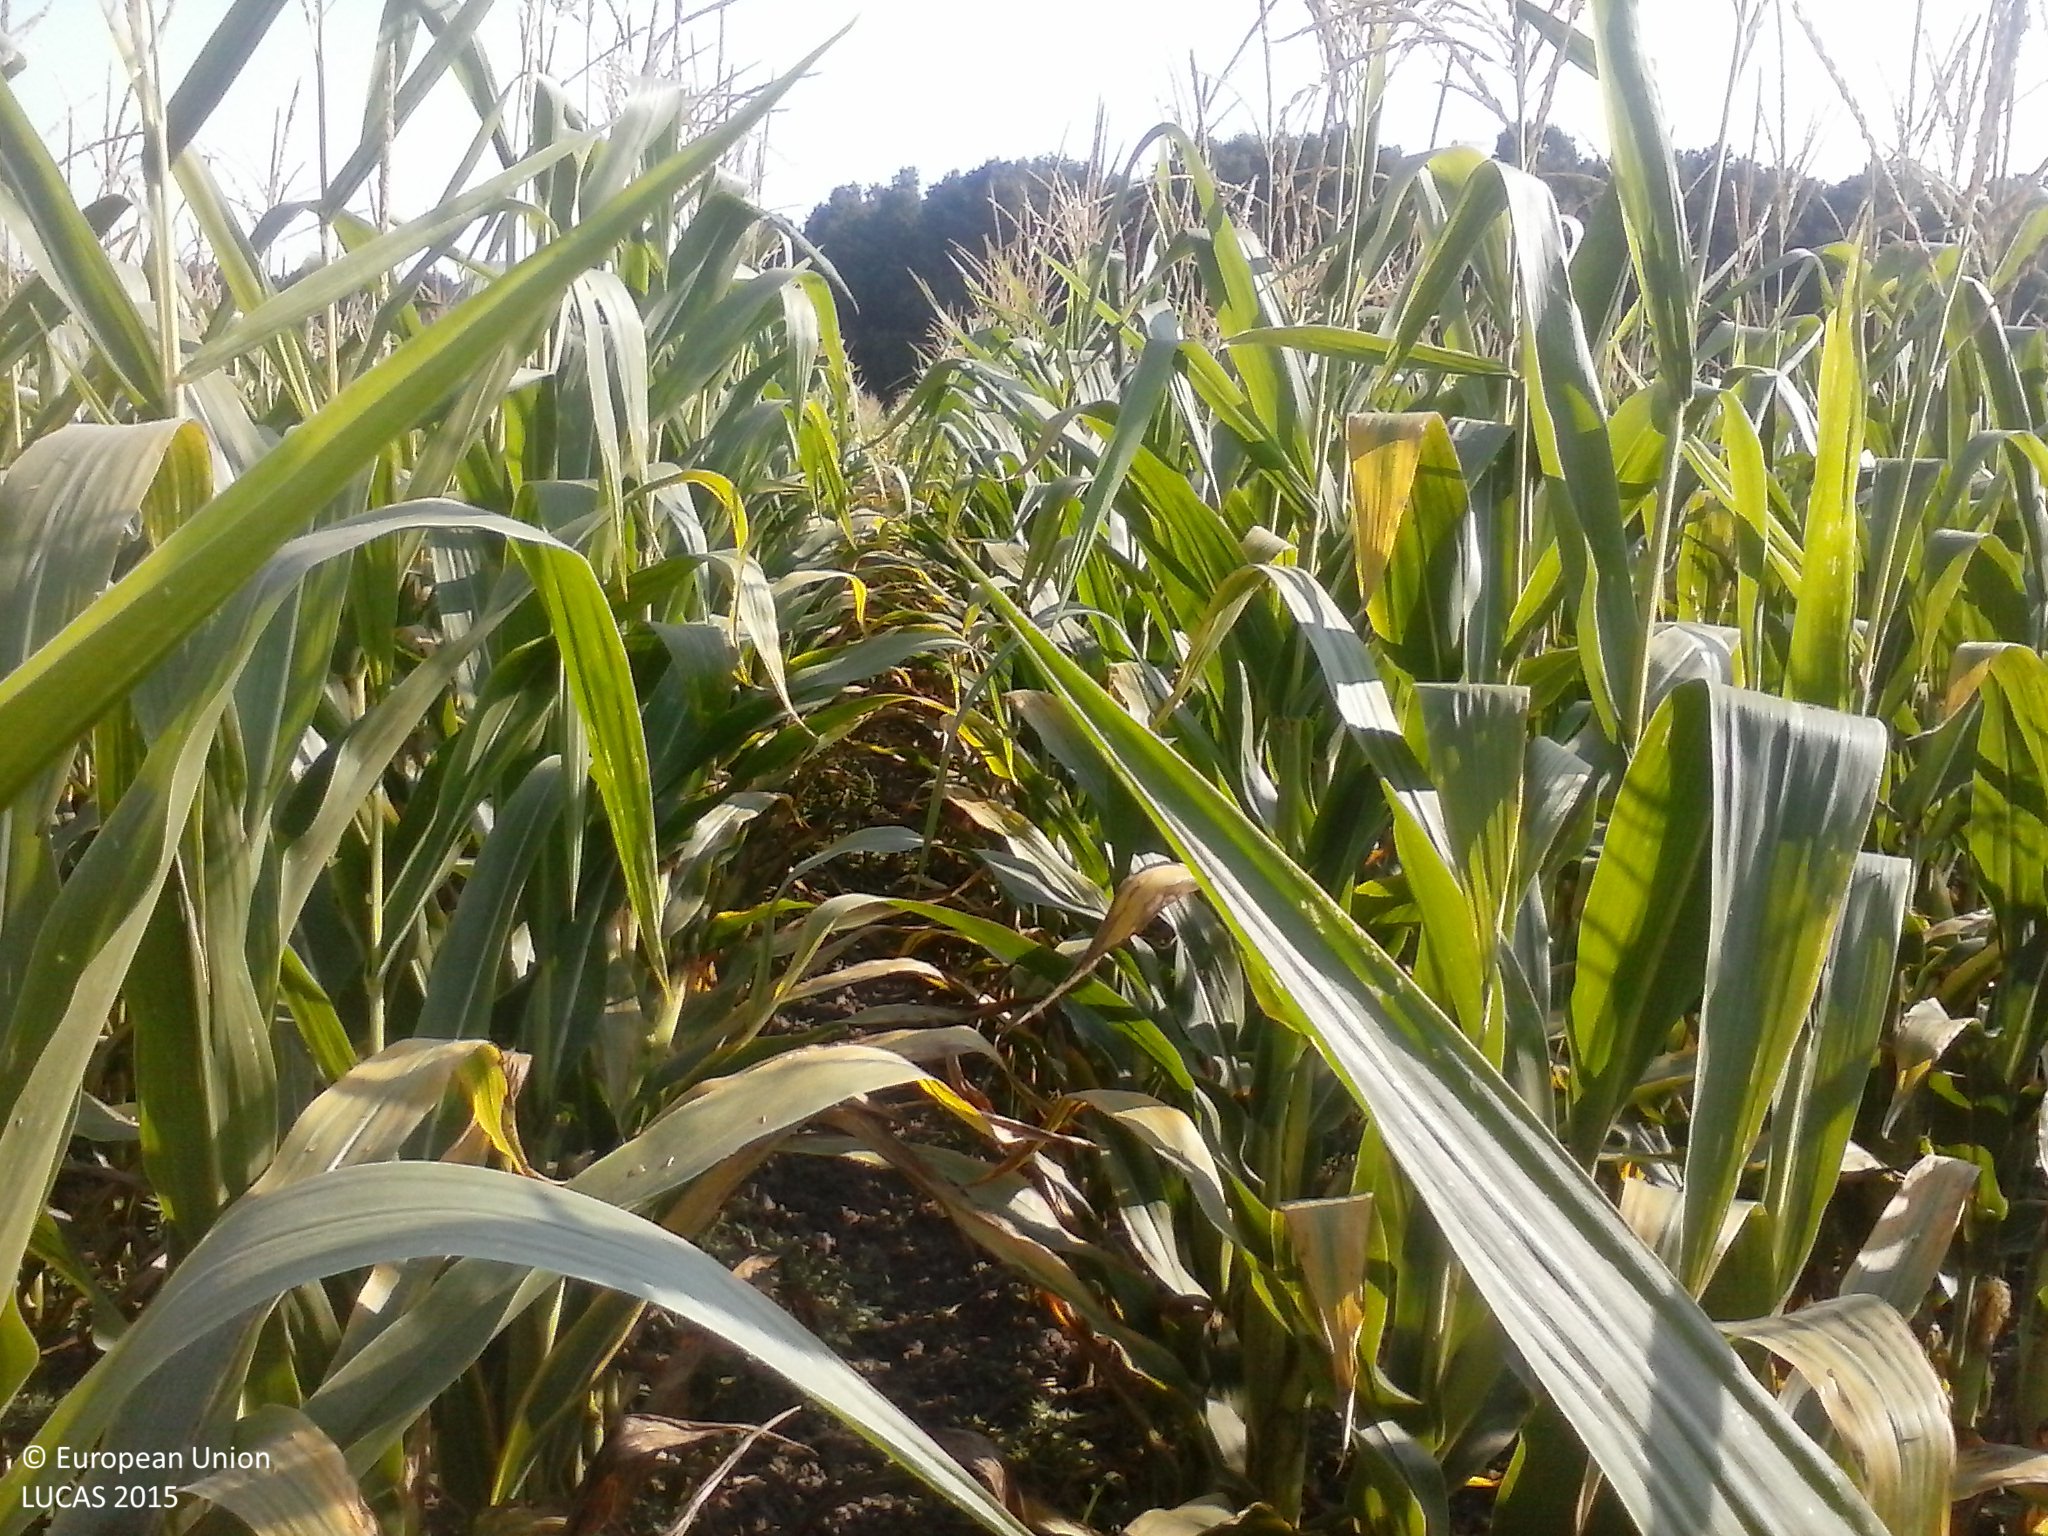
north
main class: Cropland
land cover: Maize
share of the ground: > 75 %
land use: Agriculture (excluding fallow land and kitchen gardens)
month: August
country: HU
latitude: 45.8955
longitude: 17.9052
